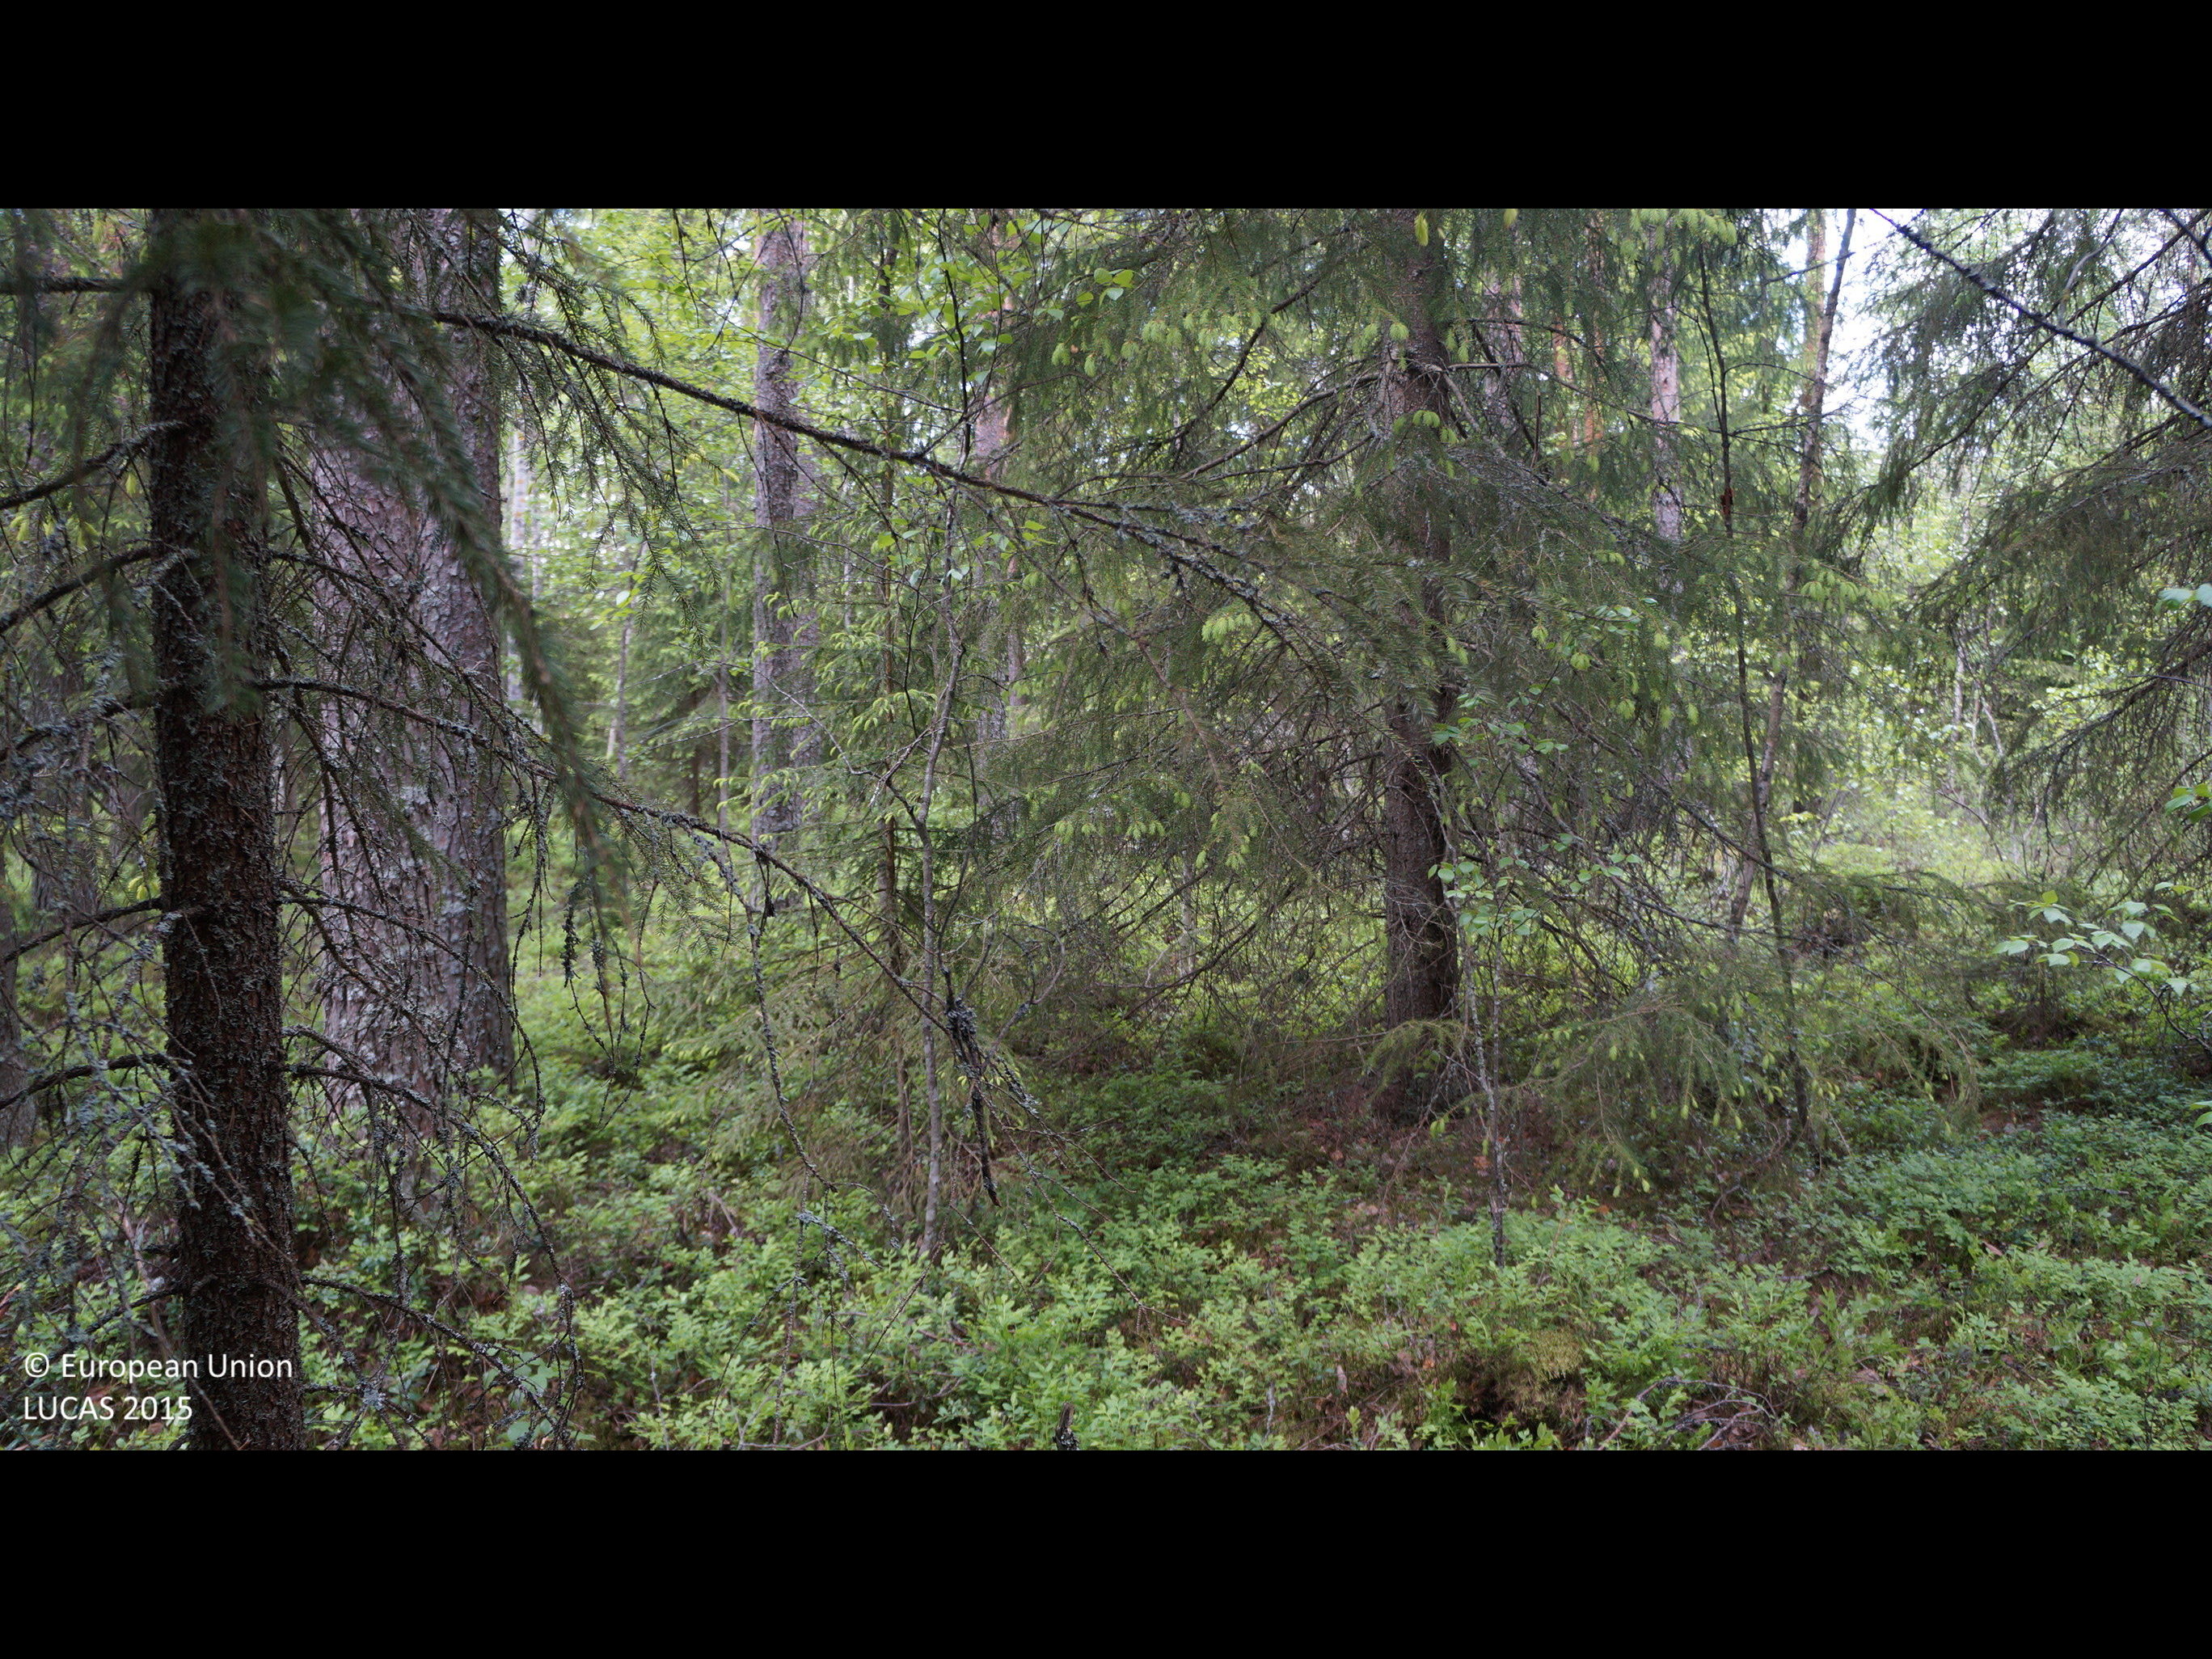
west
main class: Woodland
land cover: Other coniferous woodland
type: boreal forest
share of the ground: > 75 %
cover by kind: coniferous forest trees 70 %, shrubs 15 %, lichens and mosses 10 %, broadleaved forest trees 5 %
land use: Forestry
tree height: > 5 m
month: June
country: FI
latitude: 64.1194
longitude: 25.2213
